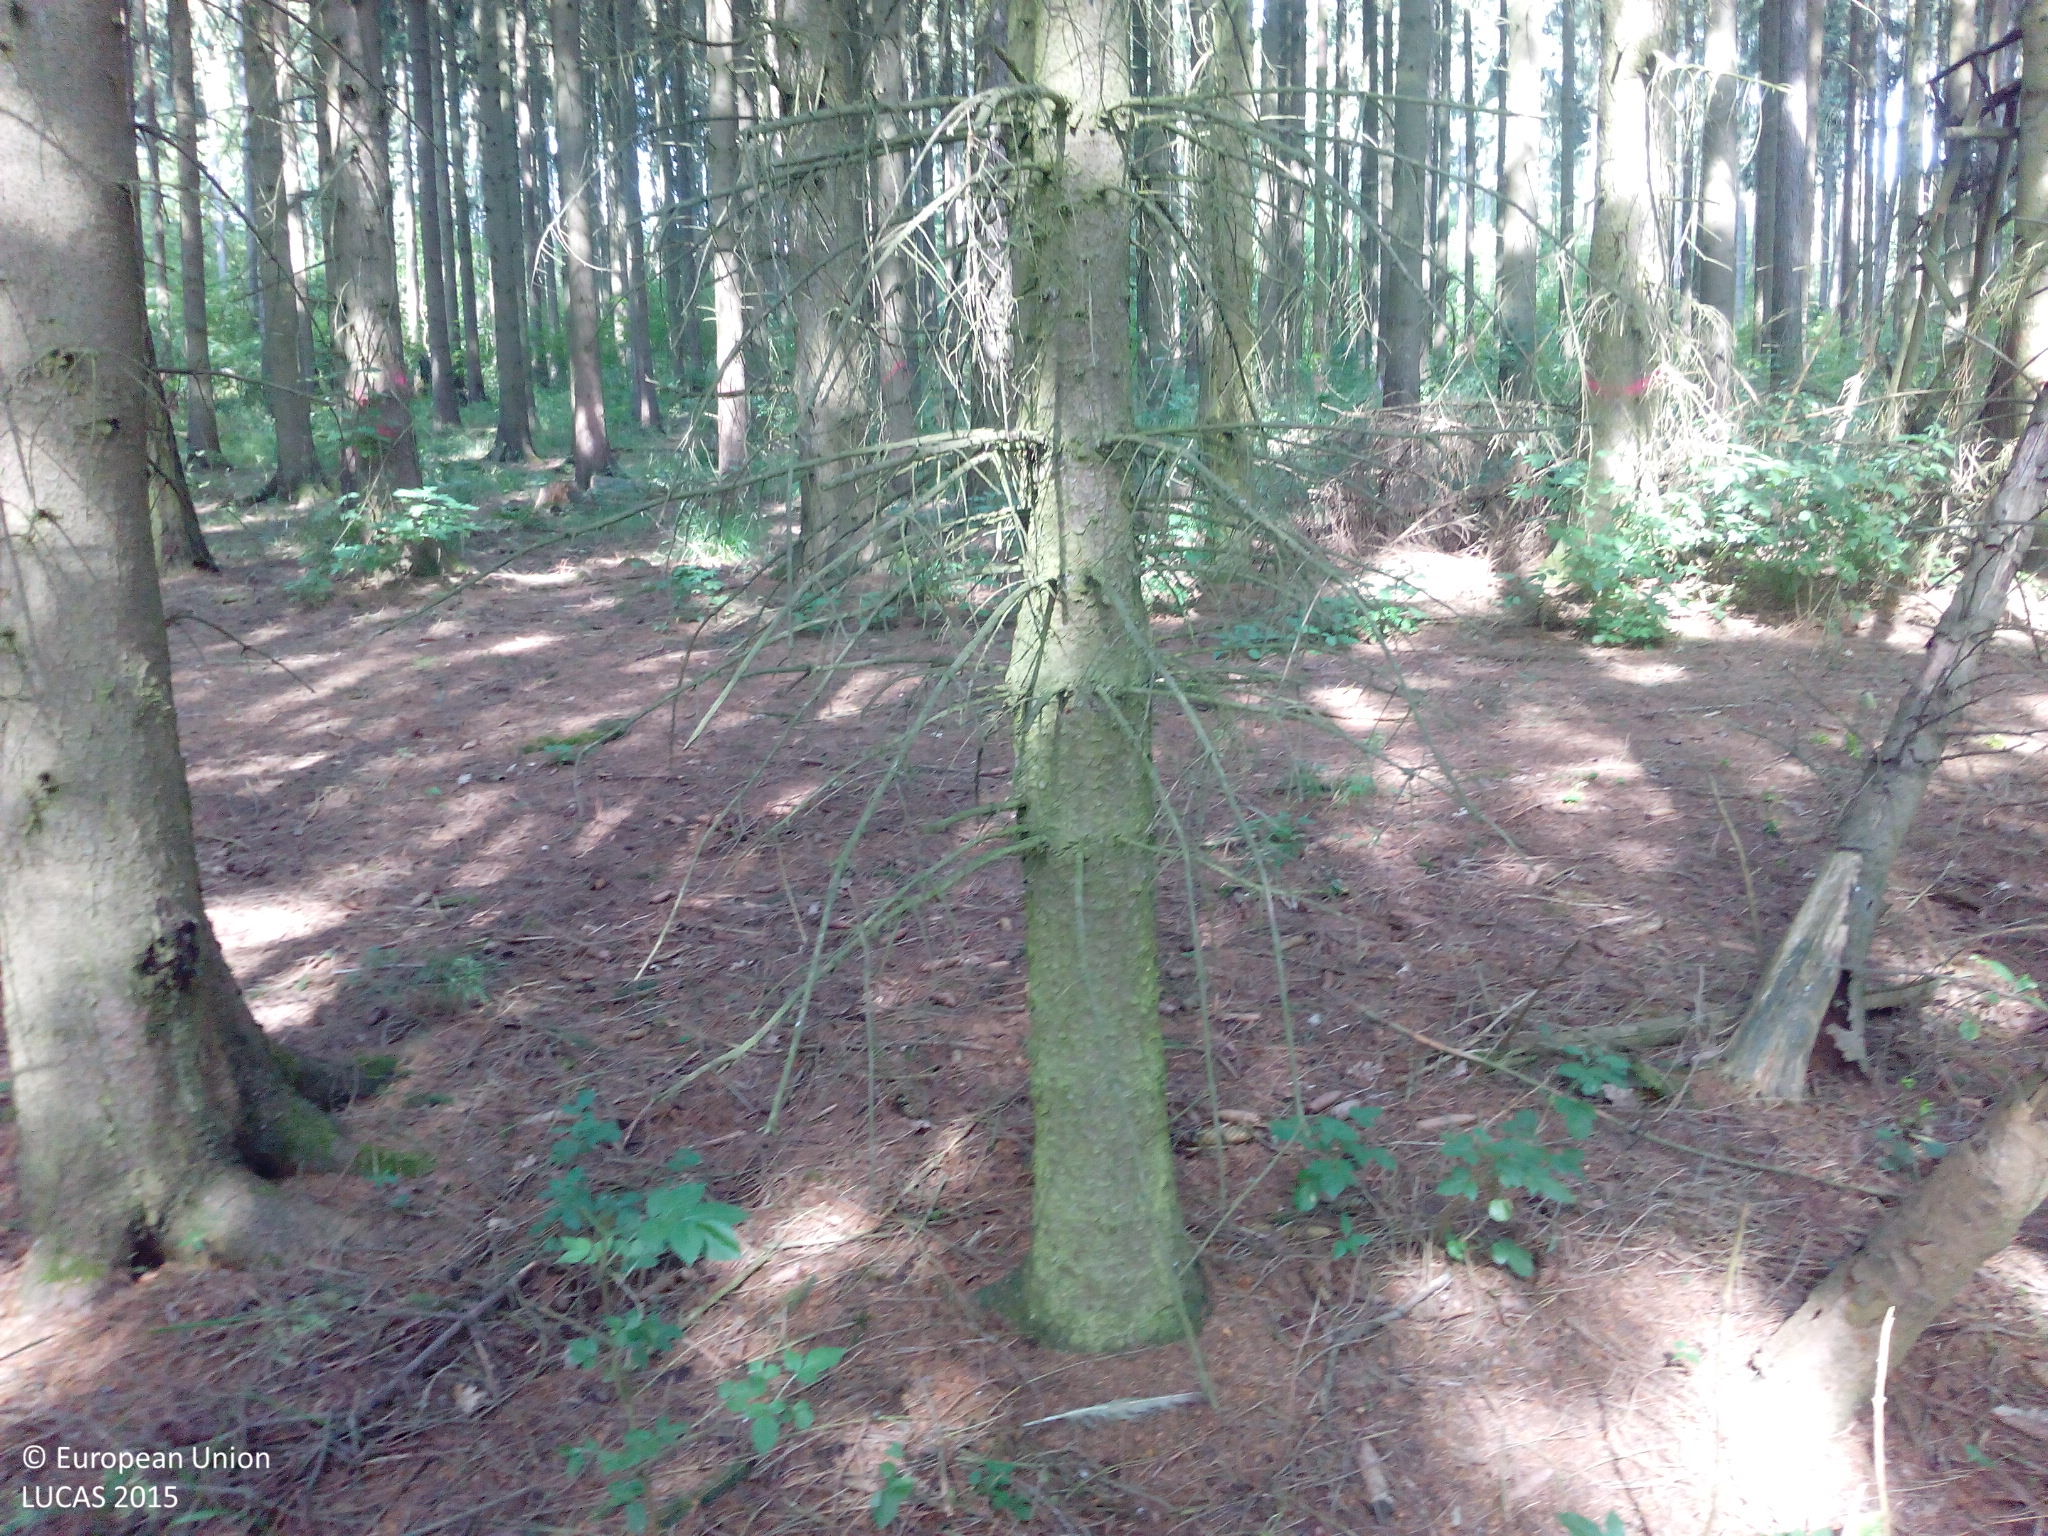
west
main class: Woodland
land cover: Spruce dominated coniferous woodland
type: hemiboreal forest and nemoral coniferous forest and mixed broadleaved-coniferous forest
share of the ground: > 75 %
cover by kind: coniferous forest trees 85 %, unconsolidated bare surface 15 %
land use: Forestry
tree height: > 5 m
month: June
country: DE
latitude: 50.3175
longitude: 8.4415
